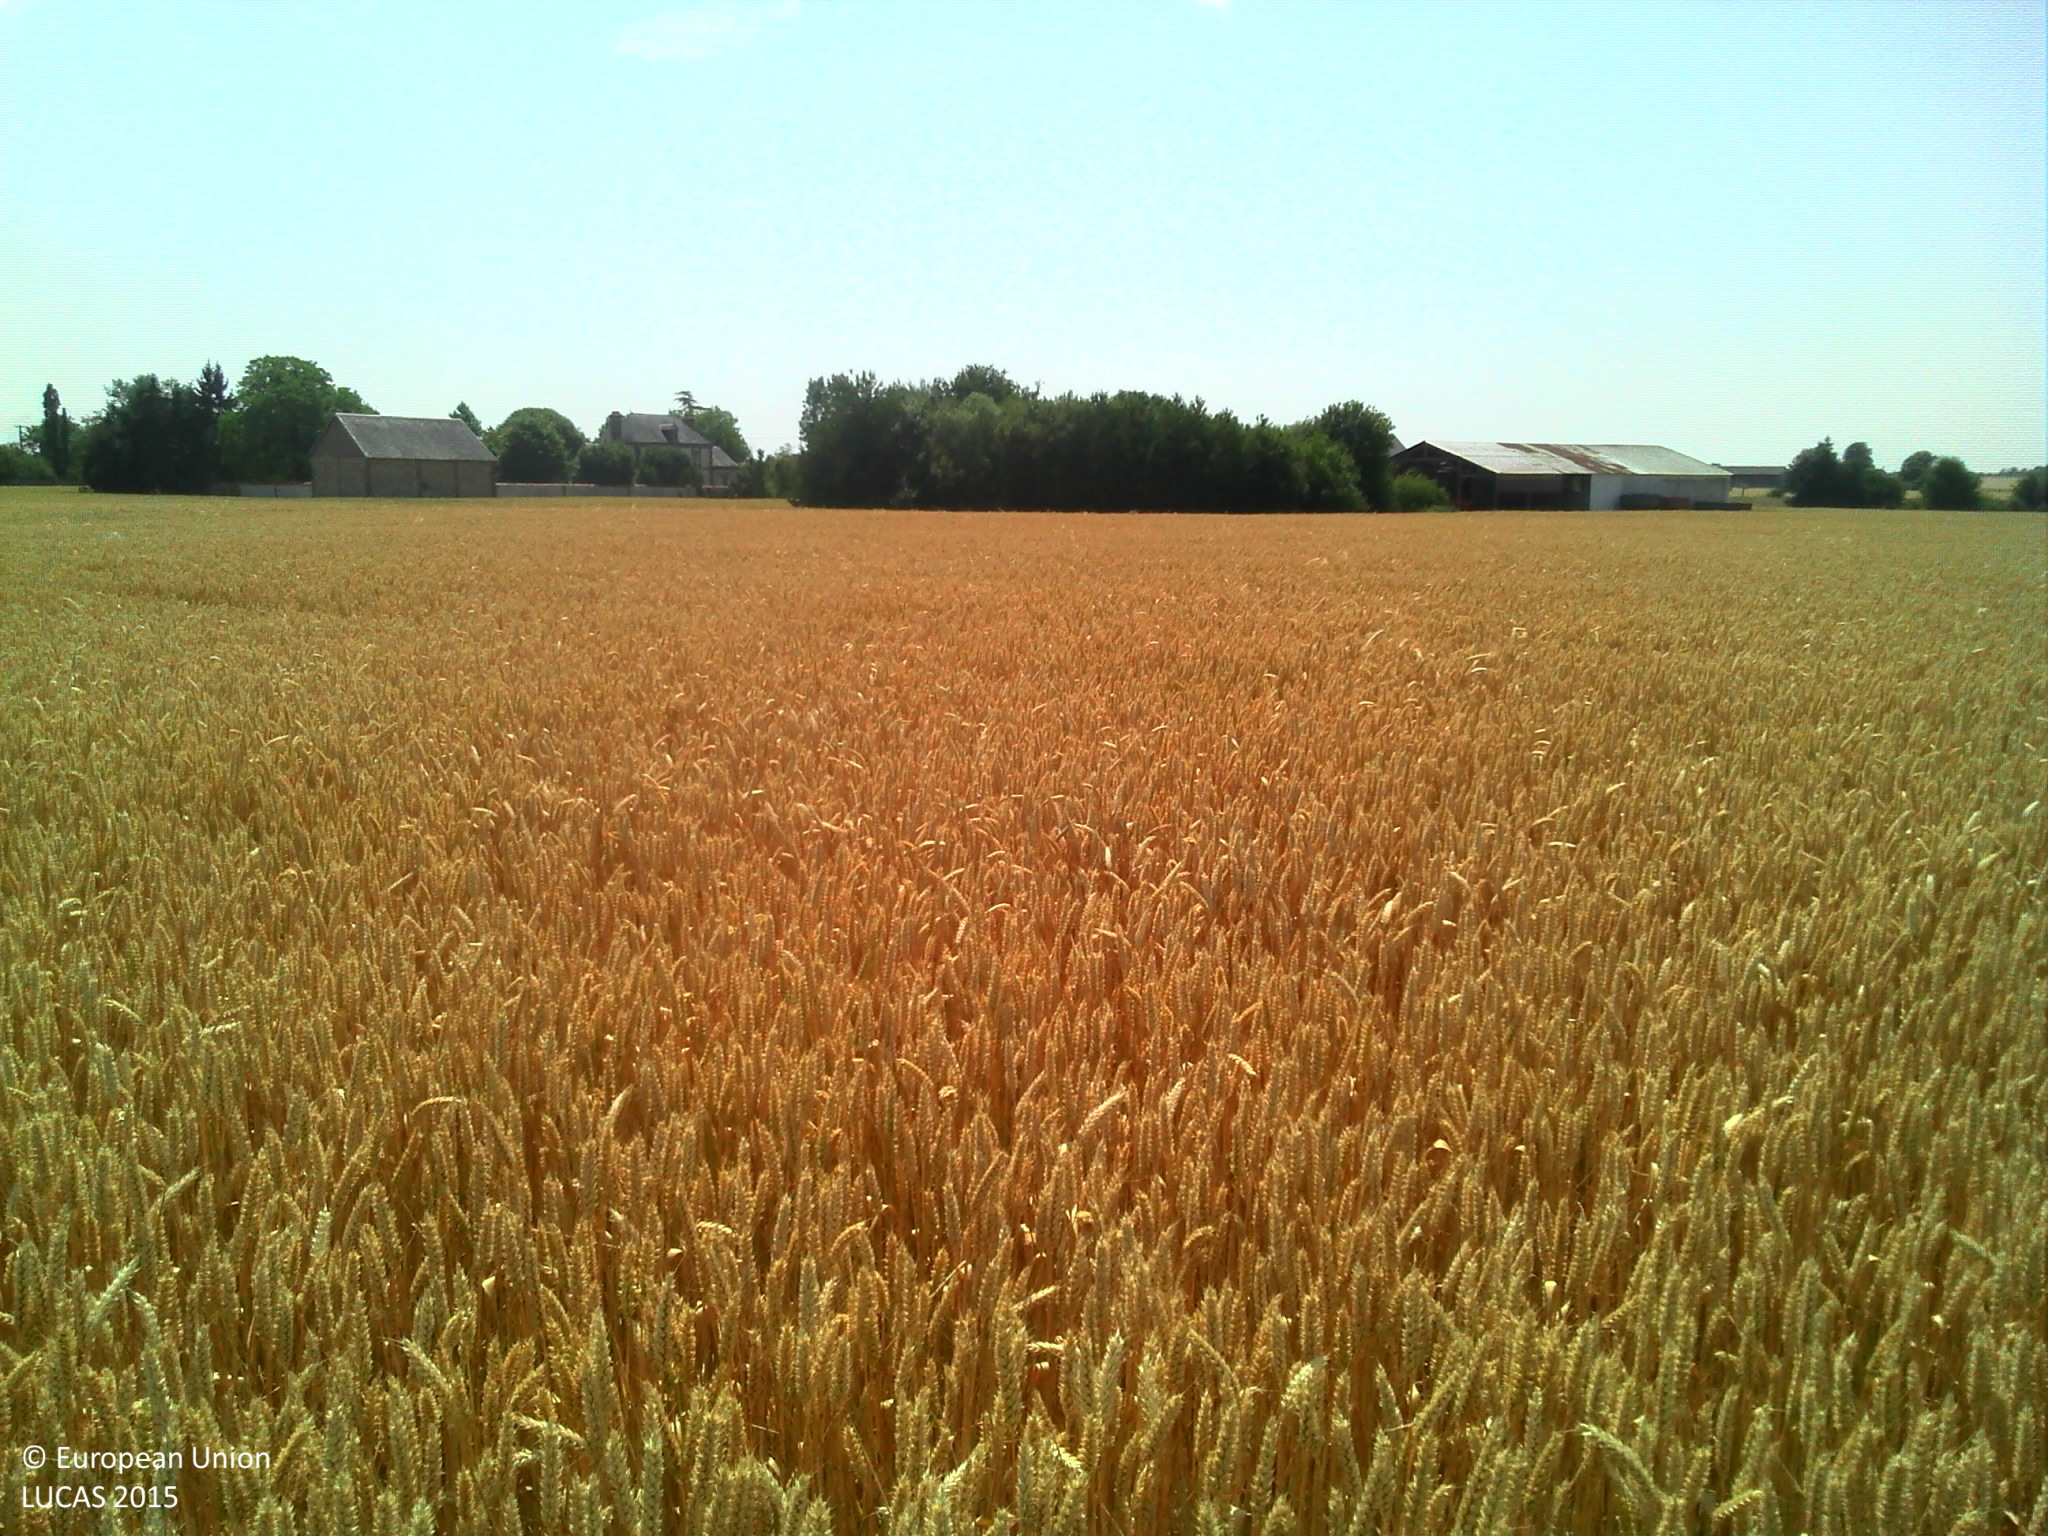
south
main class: Cropland
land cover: Common wheat
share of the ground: > 75 %
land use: Agriculture (excluding fallow land and kitchen gardens)
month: July
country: FR
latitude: 48.9411
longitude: 1.2289
